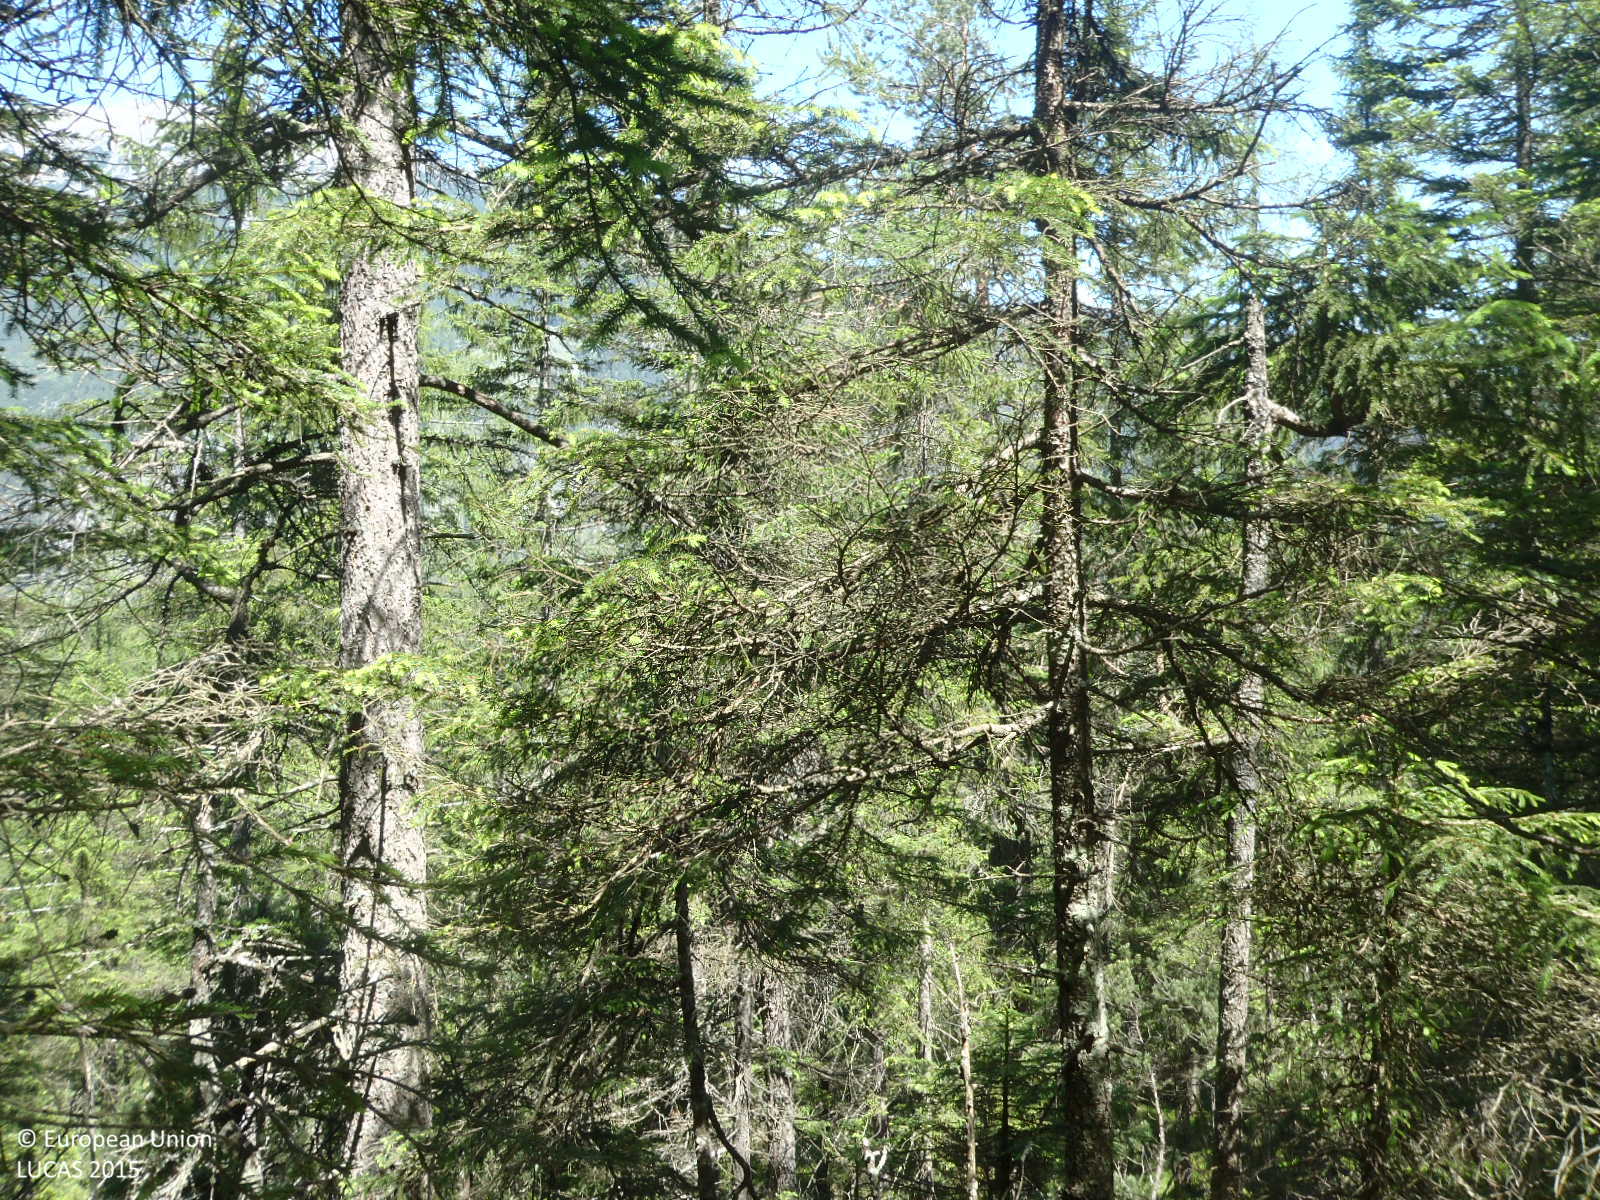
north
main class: Woodland
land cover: Spruce dominated coniferous woodland
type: alpine coniferous forest
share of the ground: > 75 %
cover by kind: coniferous forest trees 100 %
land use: Forestry
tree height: > 5 m
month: June
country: AT
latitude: 47.3562
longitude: 10.8598
